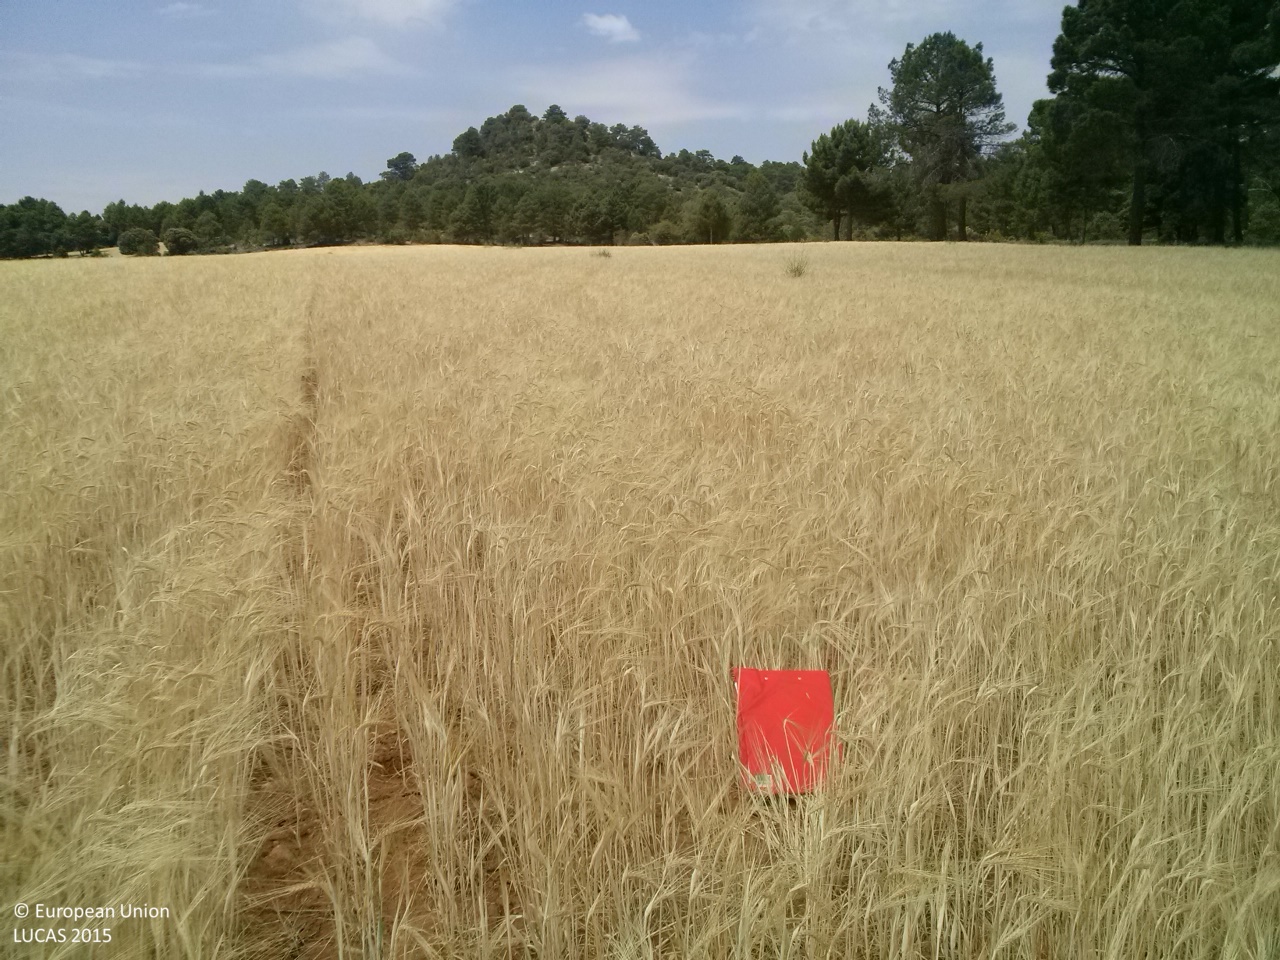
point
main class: Cropland
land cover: Barley
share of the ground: > 75 %
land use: Agriculture (excluding fallow land and kitchen gardens)
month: June
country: ES
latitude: 39.9724
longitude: -1.8023
